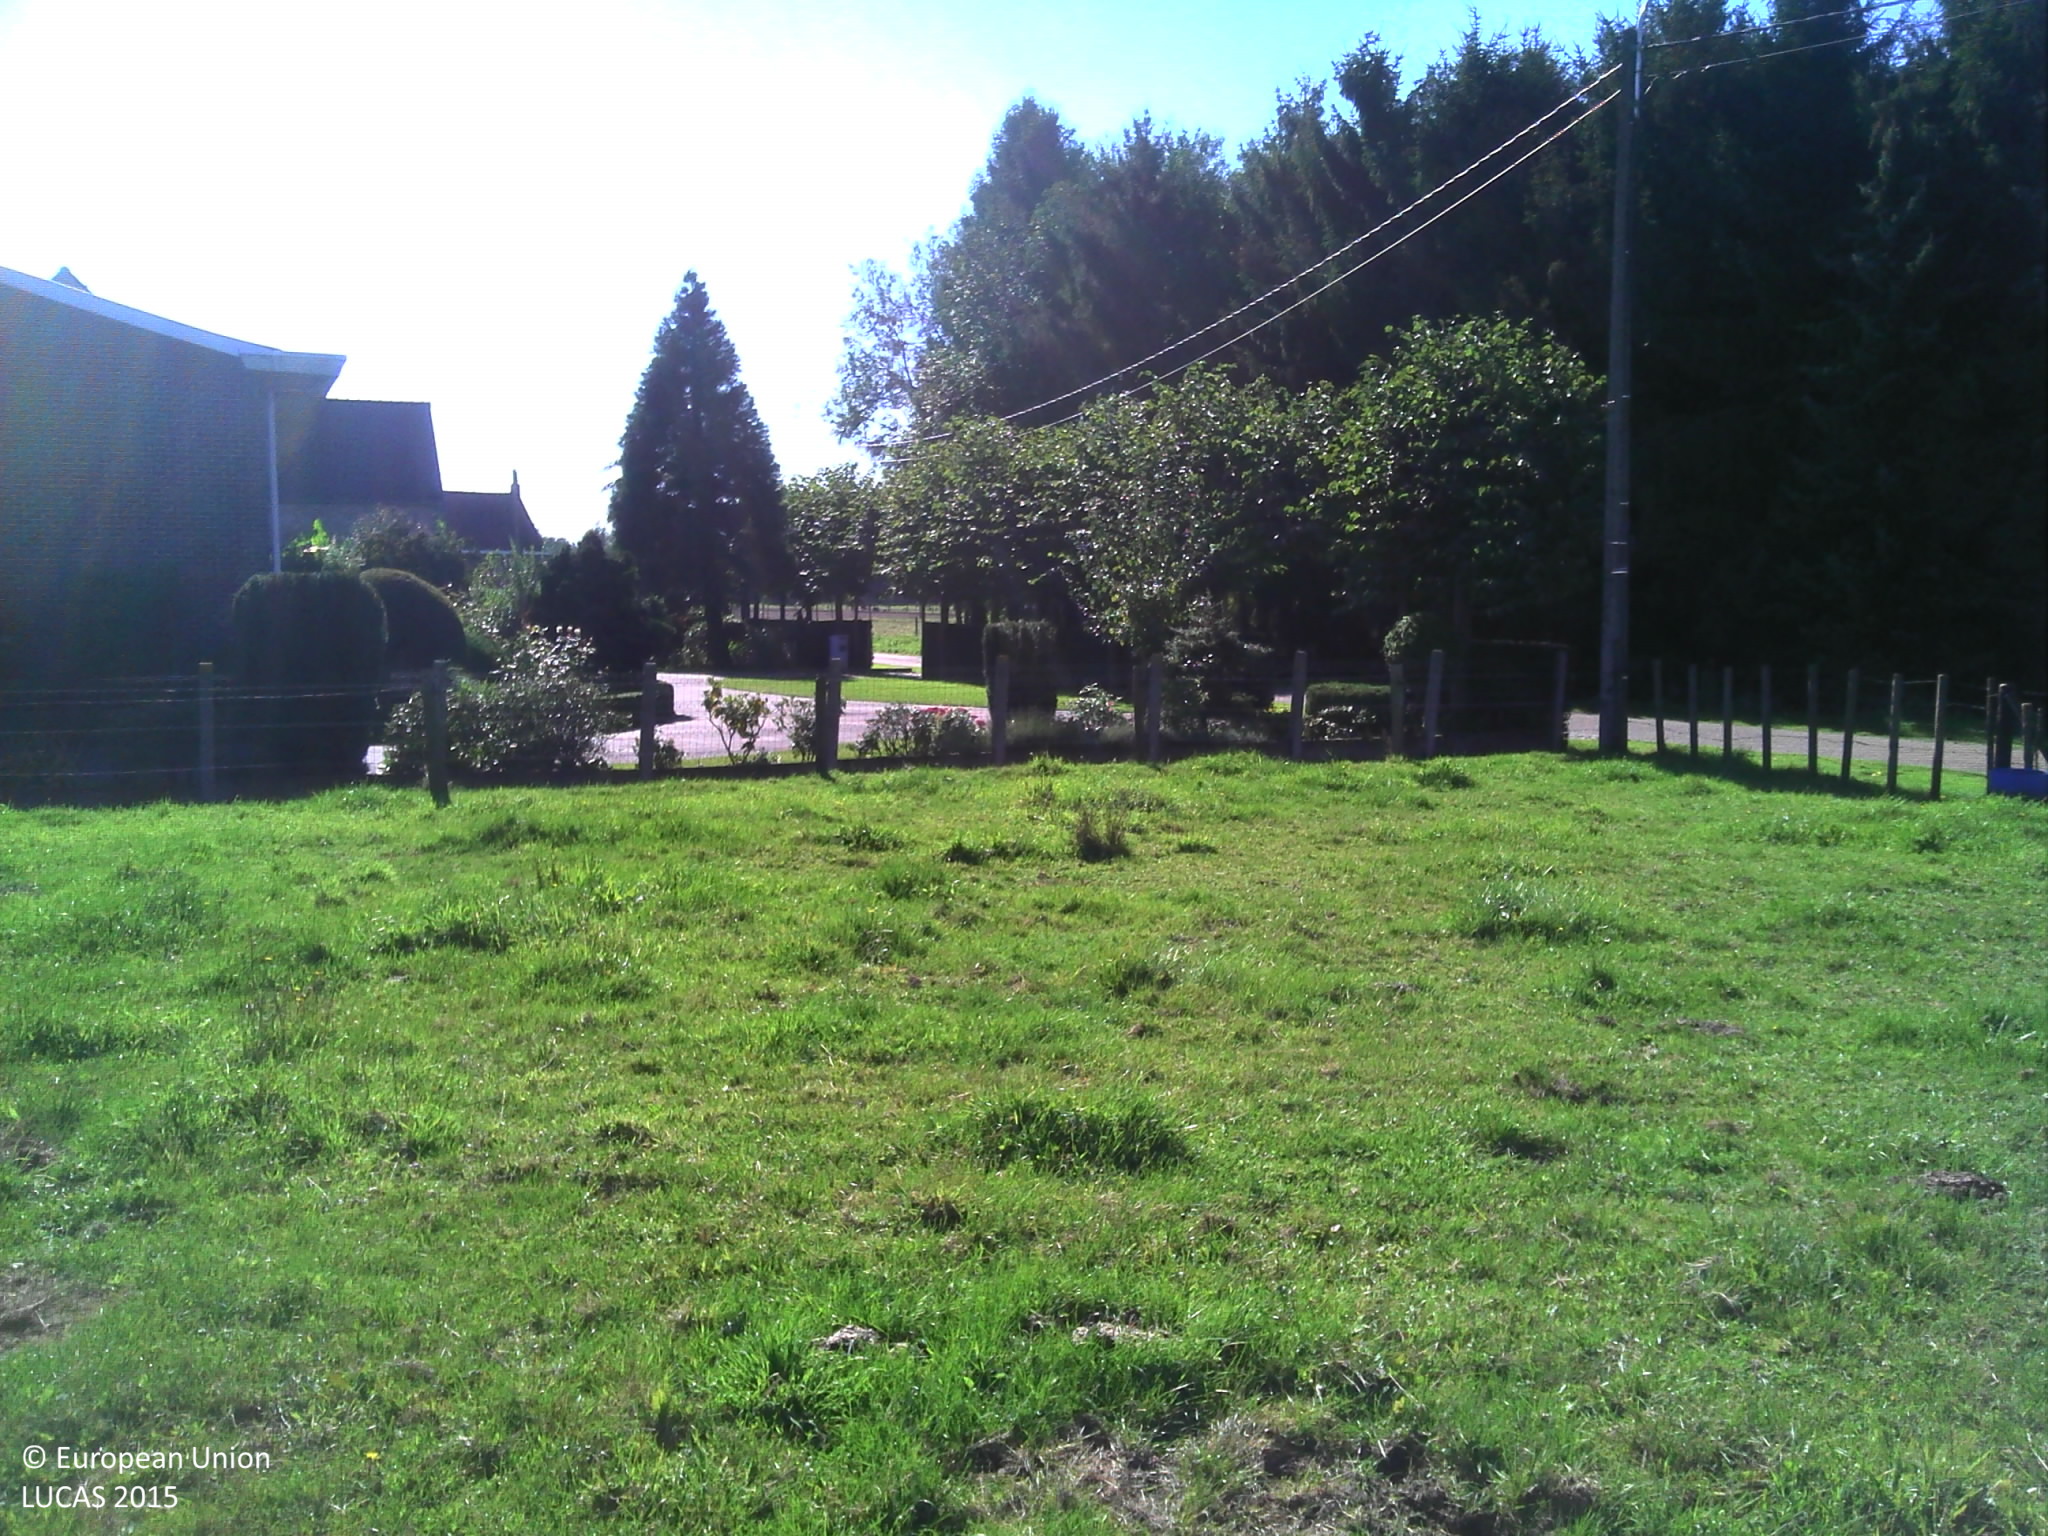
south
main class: Grassland
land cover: Grassland without tree/shrub cover
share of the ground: > 75 %
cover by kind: herbaceous plants 100 %
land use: Agriculture (excluding fallow land and kitchen gardens)
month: September
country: BE
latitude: 51.2546
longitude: 4.7953
